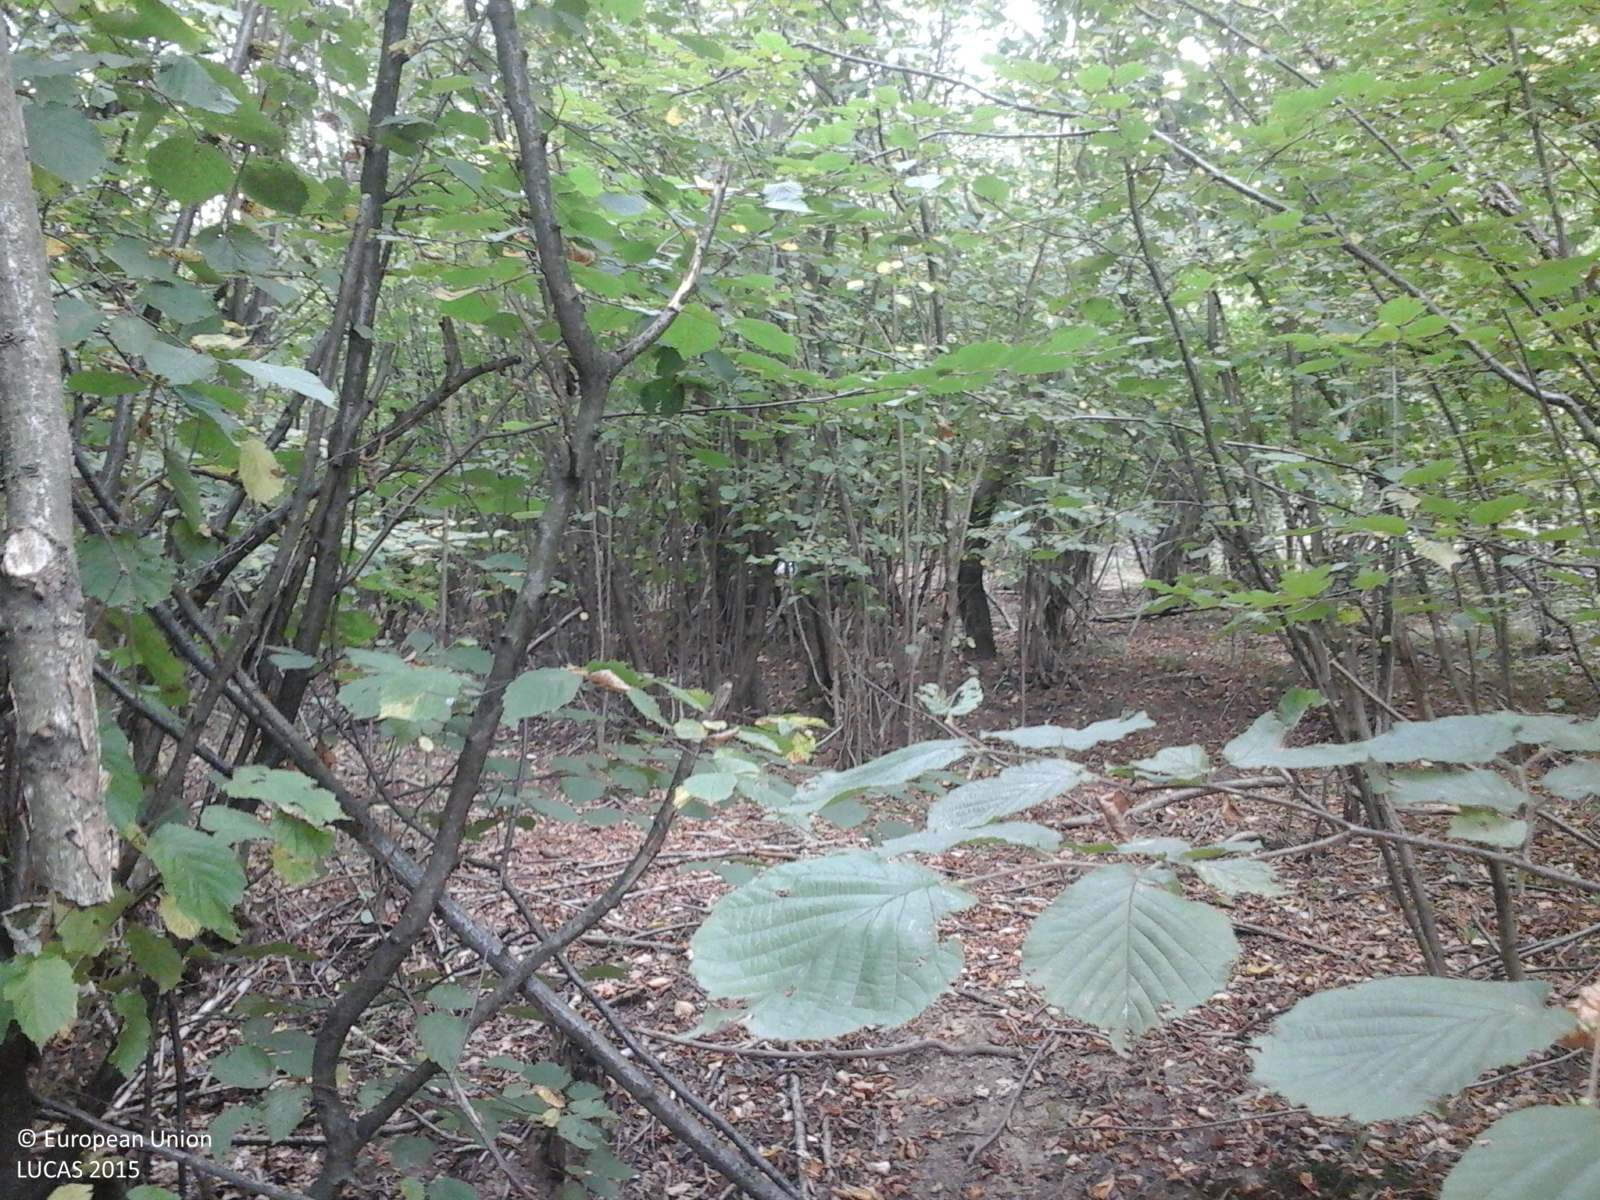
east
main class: Woodland
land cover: Broadleaved woodland
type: non-riverine alder, birch or aspen forest
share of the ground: > 75 %
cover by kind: broadleaved forest trees 100 %
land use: Forestry
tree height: > 5 m
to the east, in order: Broadleaved woodland; Tracks; Broadleaved woodland
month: September
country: RO
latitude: 47.9509
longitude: 23.6703
